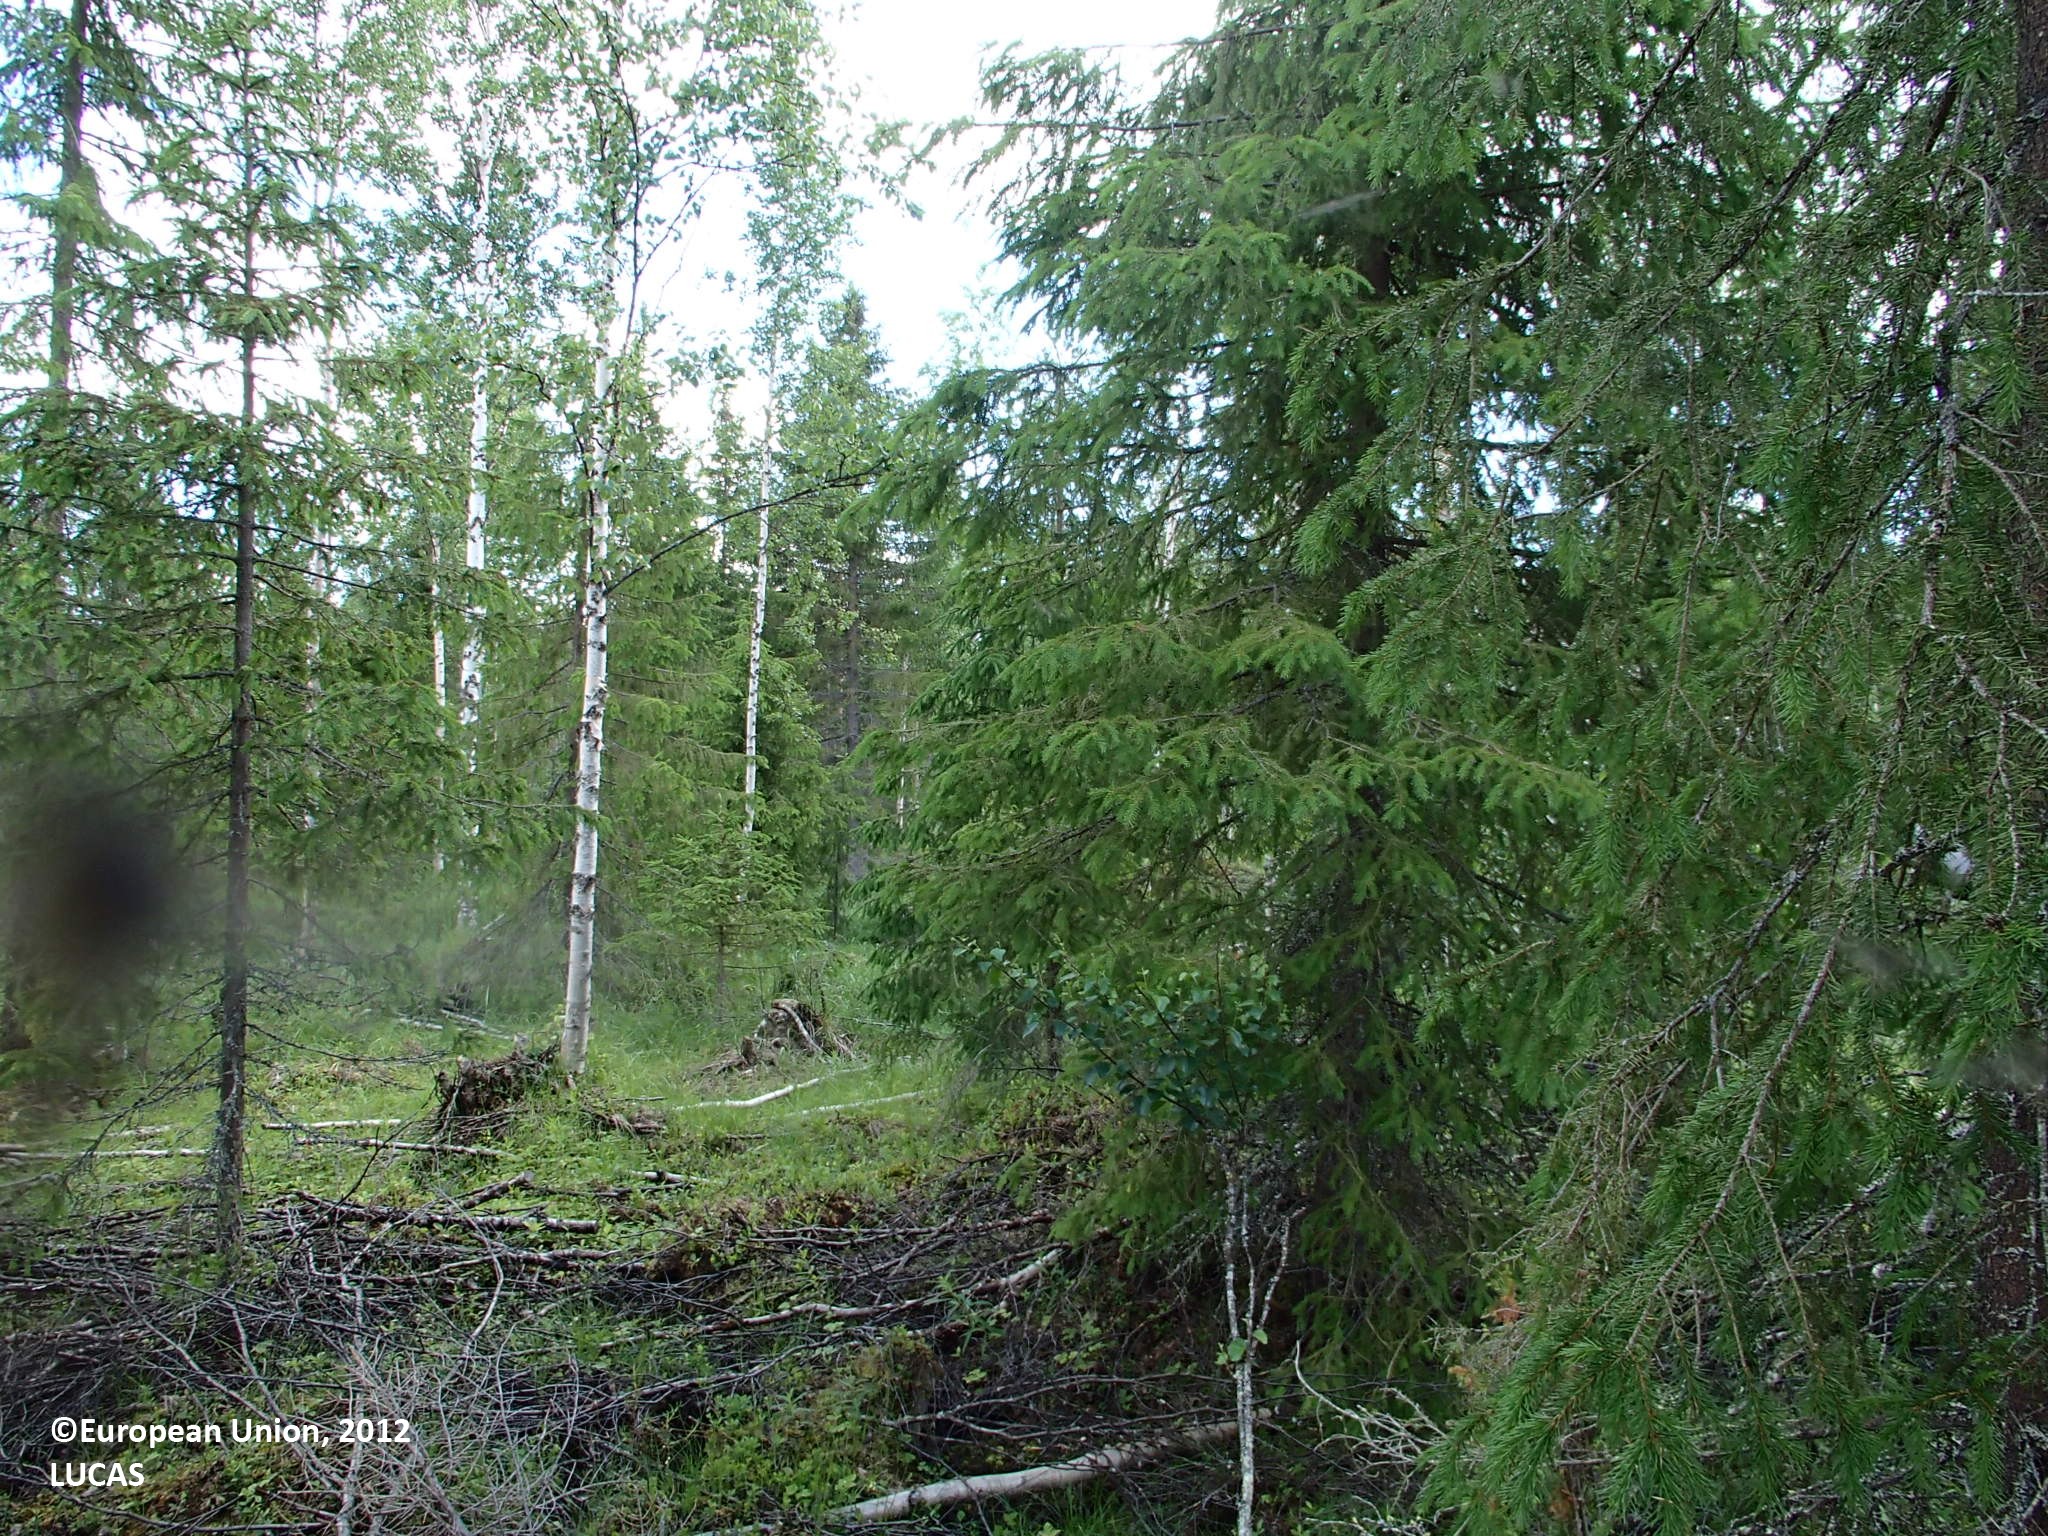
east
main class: Woodland
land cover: Other mixed woodland
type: boreal forest
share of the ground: > 75 %
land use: Forestry
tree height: > 5 m
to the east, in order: Other mixed woodland; Ditches and canals; Other mixed woodland; Ditches and canals; Other mixed woodland
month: July
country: FI
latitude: 67.3467
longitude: 26.9535
